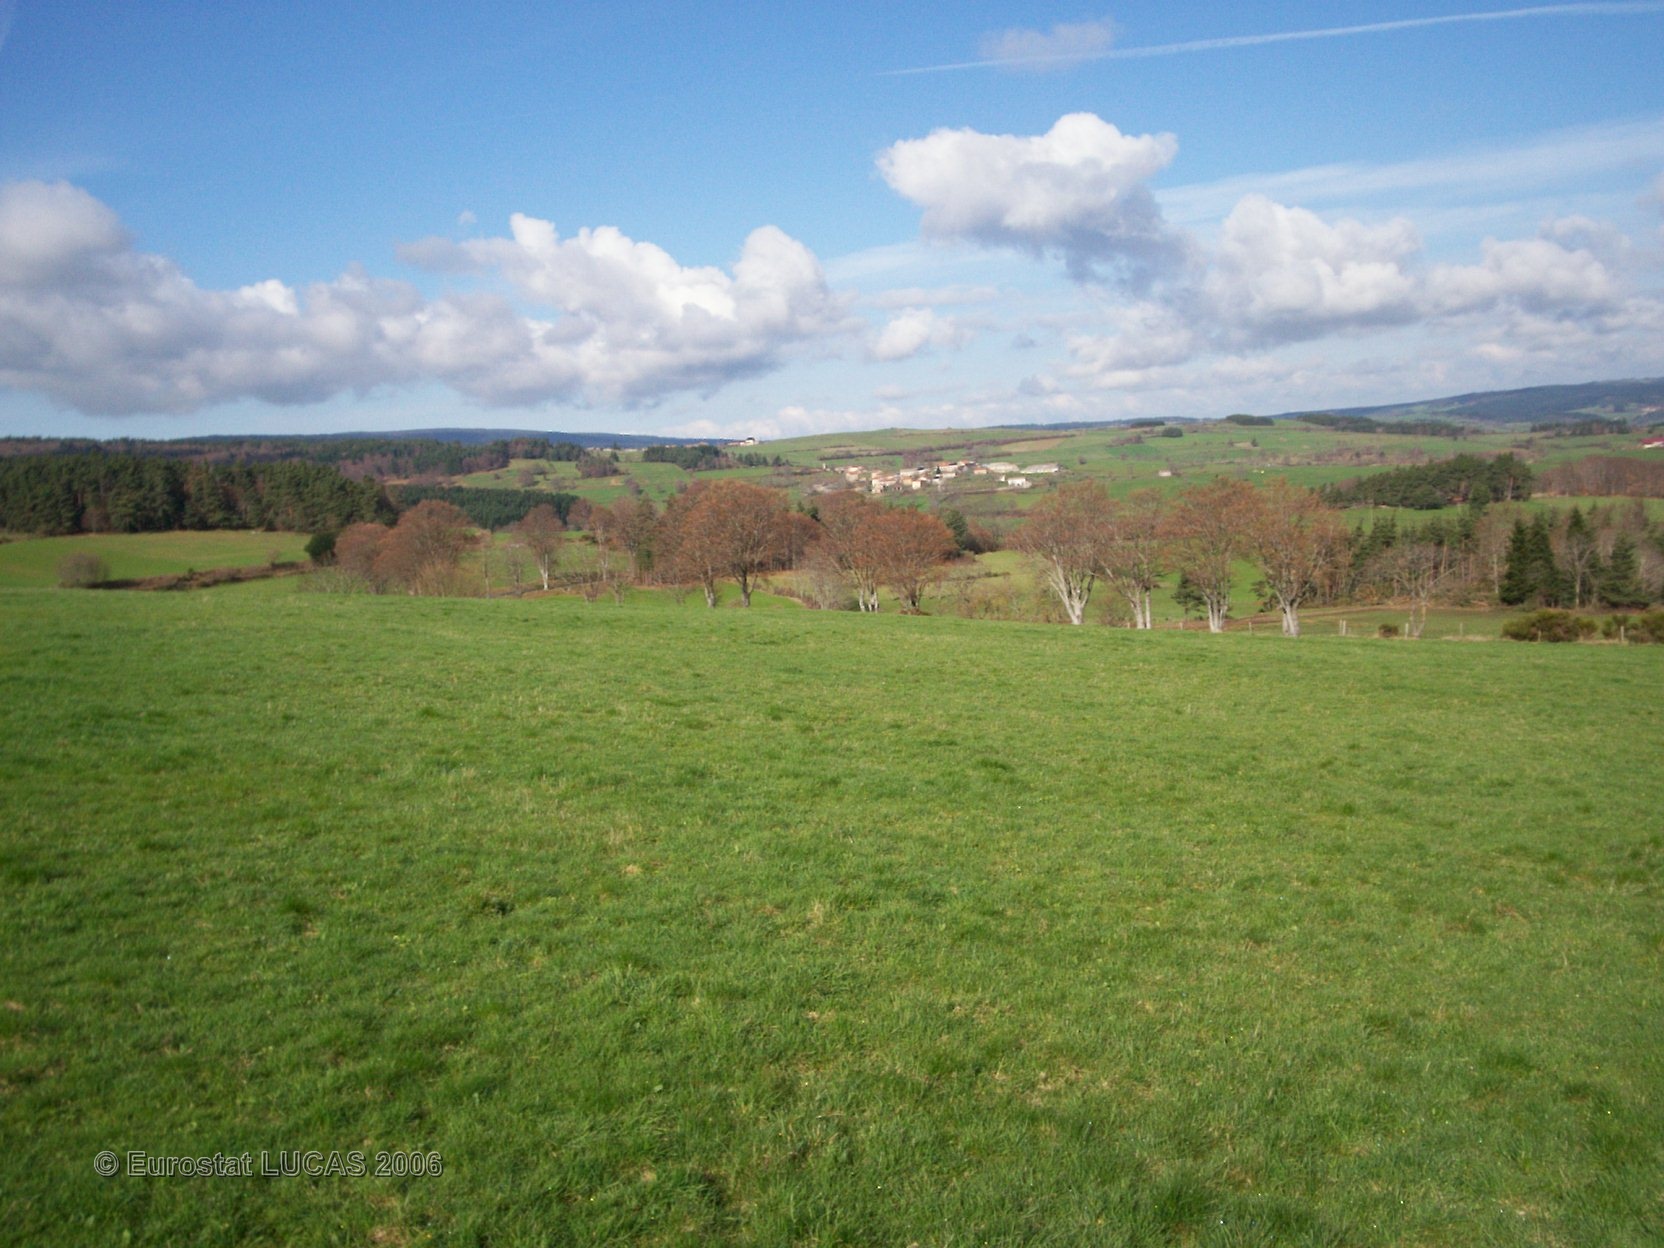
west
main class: Grassland
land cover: Grassland without tree/shrub cover
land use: Agriculture (excluding fallow land and kitchen gardens)
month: April
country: FR
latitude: 45.0603
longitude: 3.3612
